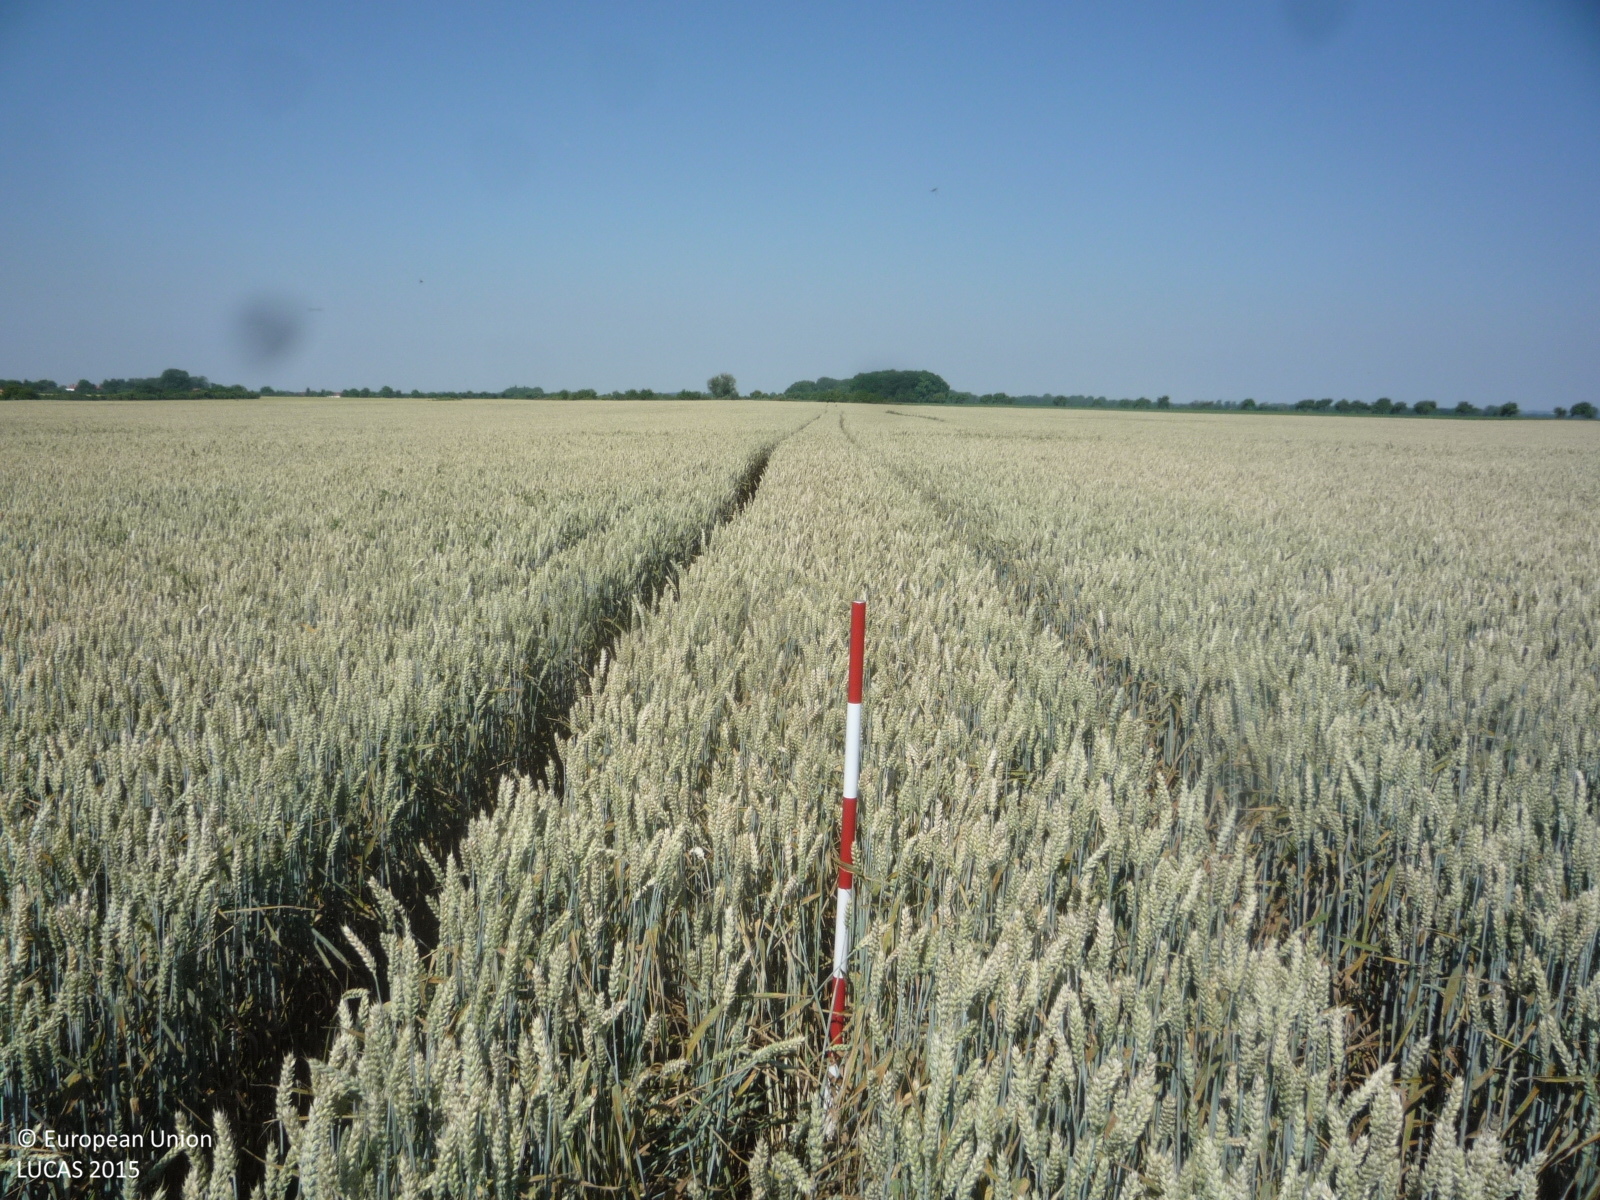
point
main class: Cropland
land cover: Common wheat
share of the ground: > 75 %
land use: Agriculture (excluding fallow land and kitchen gardens)
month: July
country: CZ
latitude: 50.2097
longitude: 15.2019
